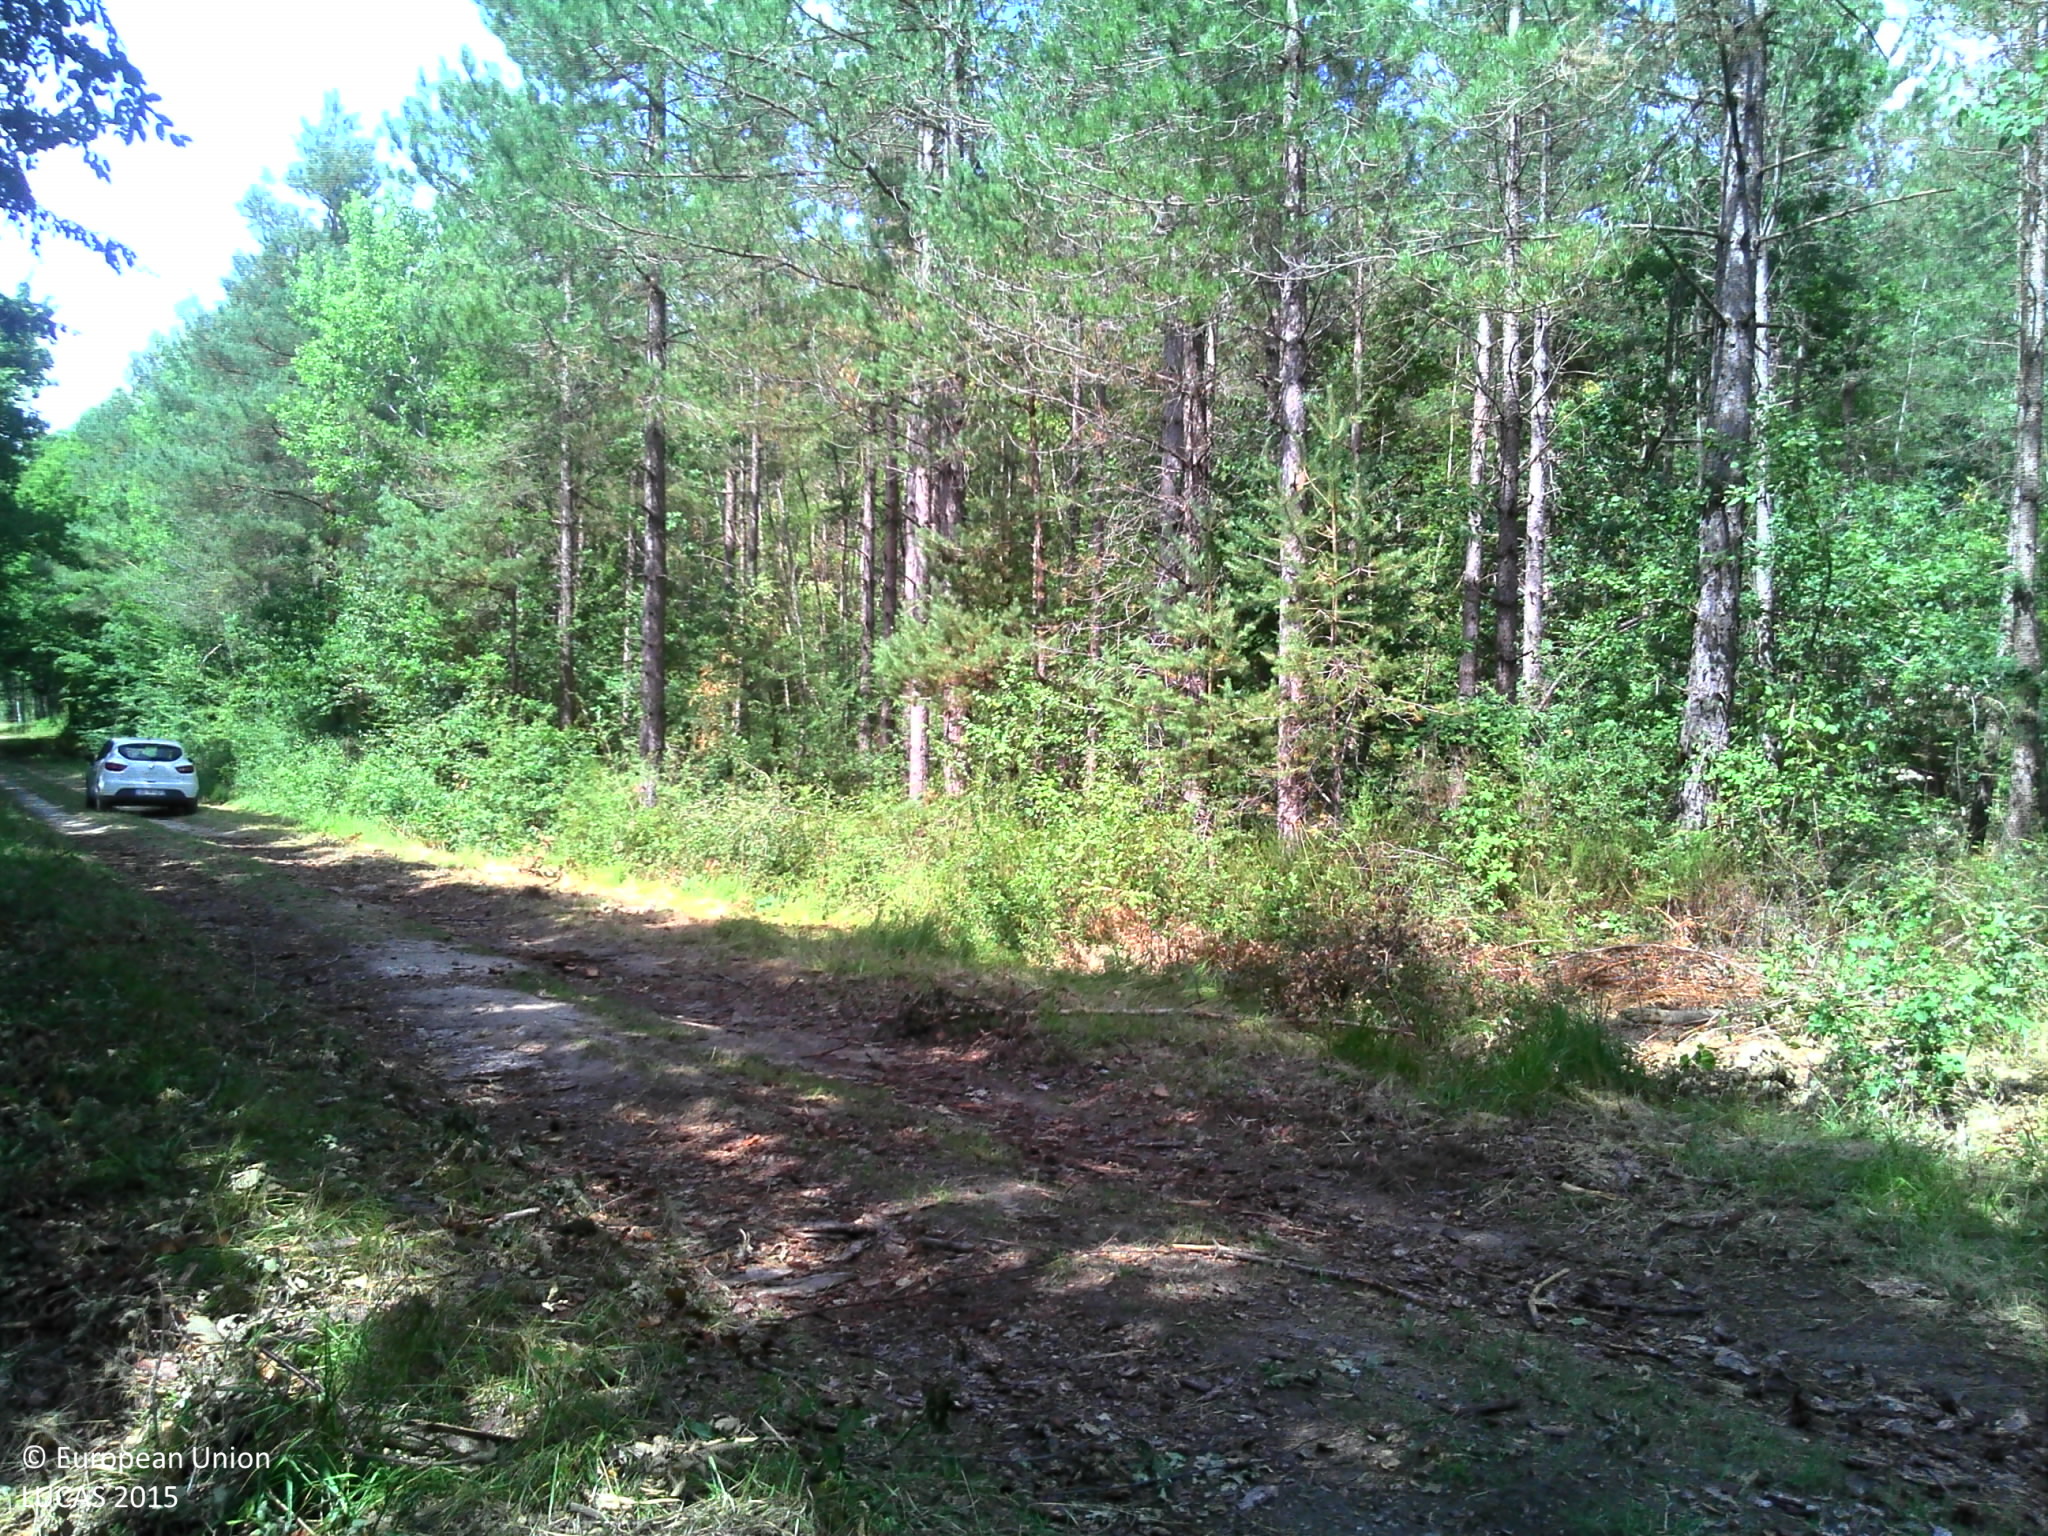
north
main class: Woodland
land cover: Broadleaved woodland
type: mesophytic deciduous forest
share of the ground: > 75 %
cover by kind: broadleaved forest trees 100 %
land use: Forestry
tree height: > 5 m
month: July
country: FR
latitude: 47.9840
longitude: 1.9619
